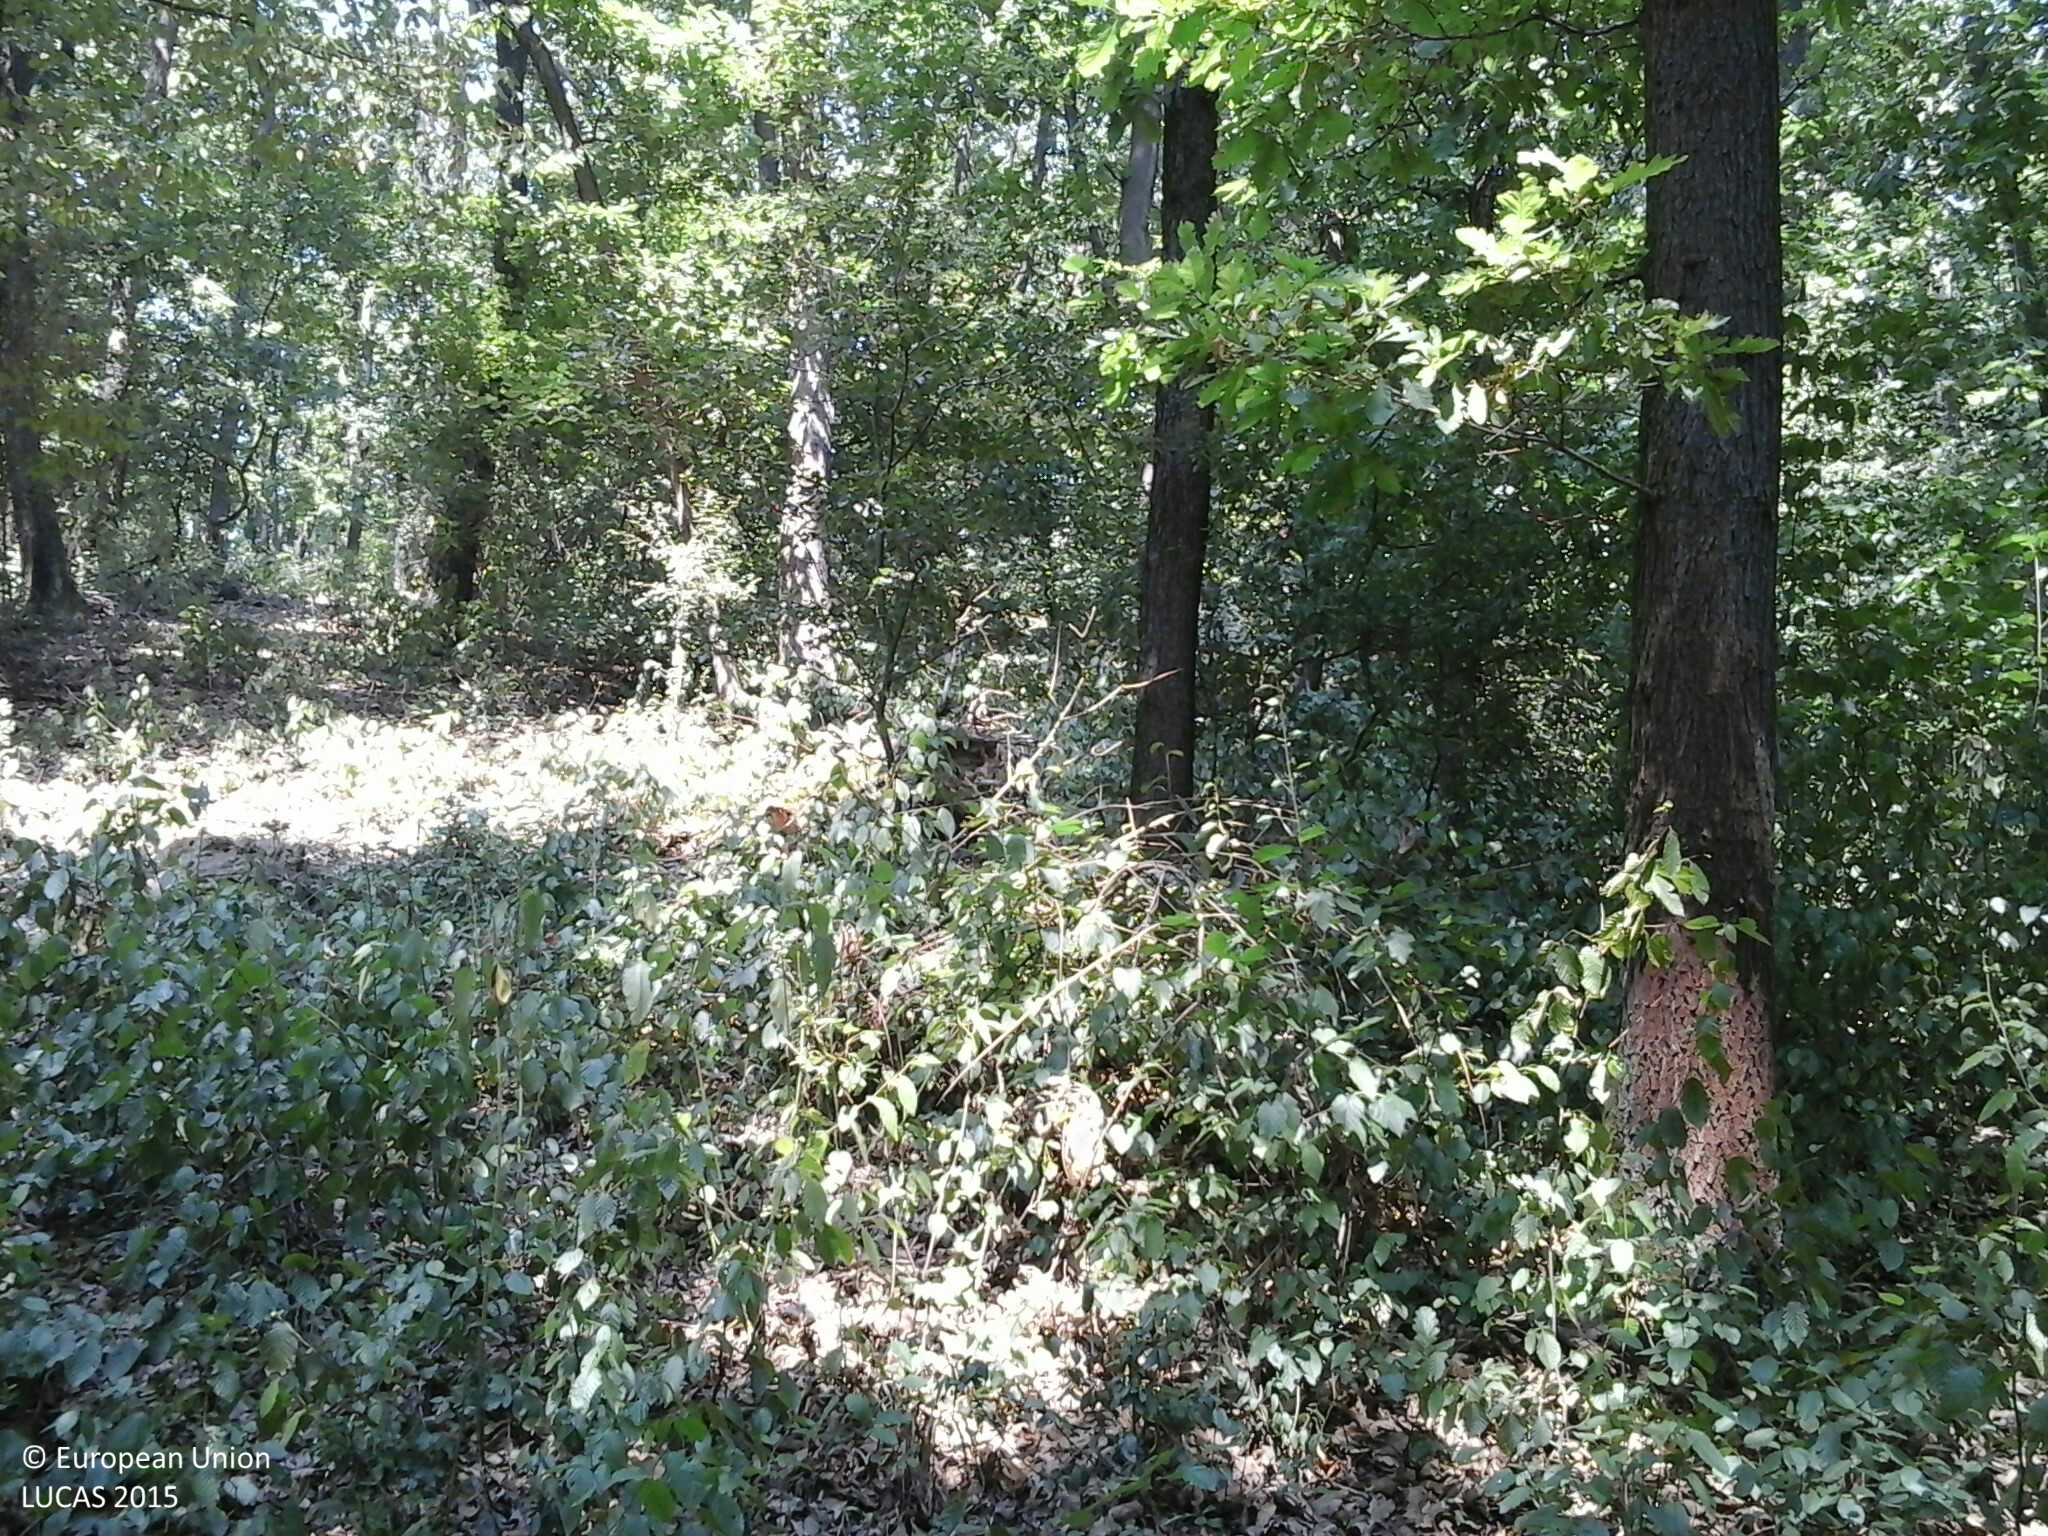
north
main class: Woodland
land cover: Broadleaved woodland
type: mesophytic deciduous forest
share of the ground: > 75 %
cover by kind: broadleaved forest trees 100 %
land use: Forestry
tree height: > 5 m
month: August
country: HU
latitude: 48.3208
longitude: 20.4860
